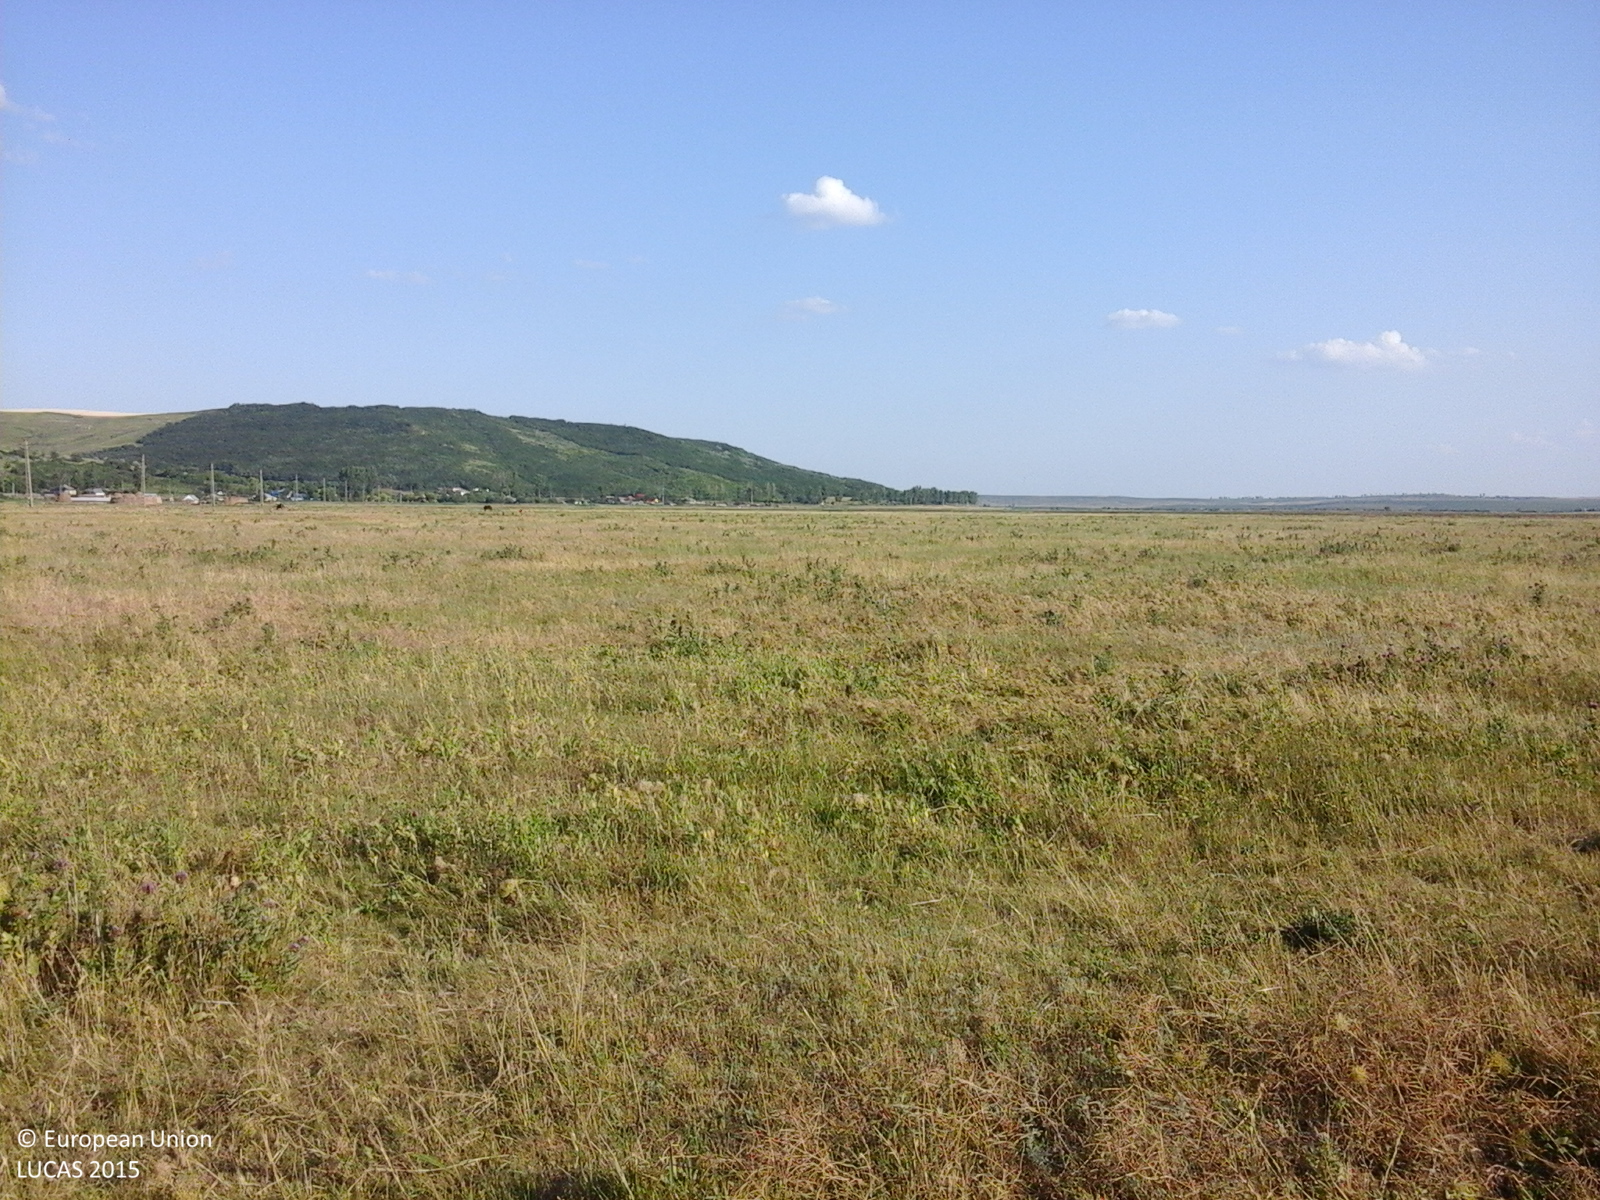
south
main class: Grassland
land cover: Grassland without tree/shrub cover
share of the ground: > 75 %
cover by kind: herbaceous plants 100 %
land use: Agriculture (excluding fallow land and kitchen gardens)
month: June
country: RO
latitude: 47.4036
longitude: 27.3526
